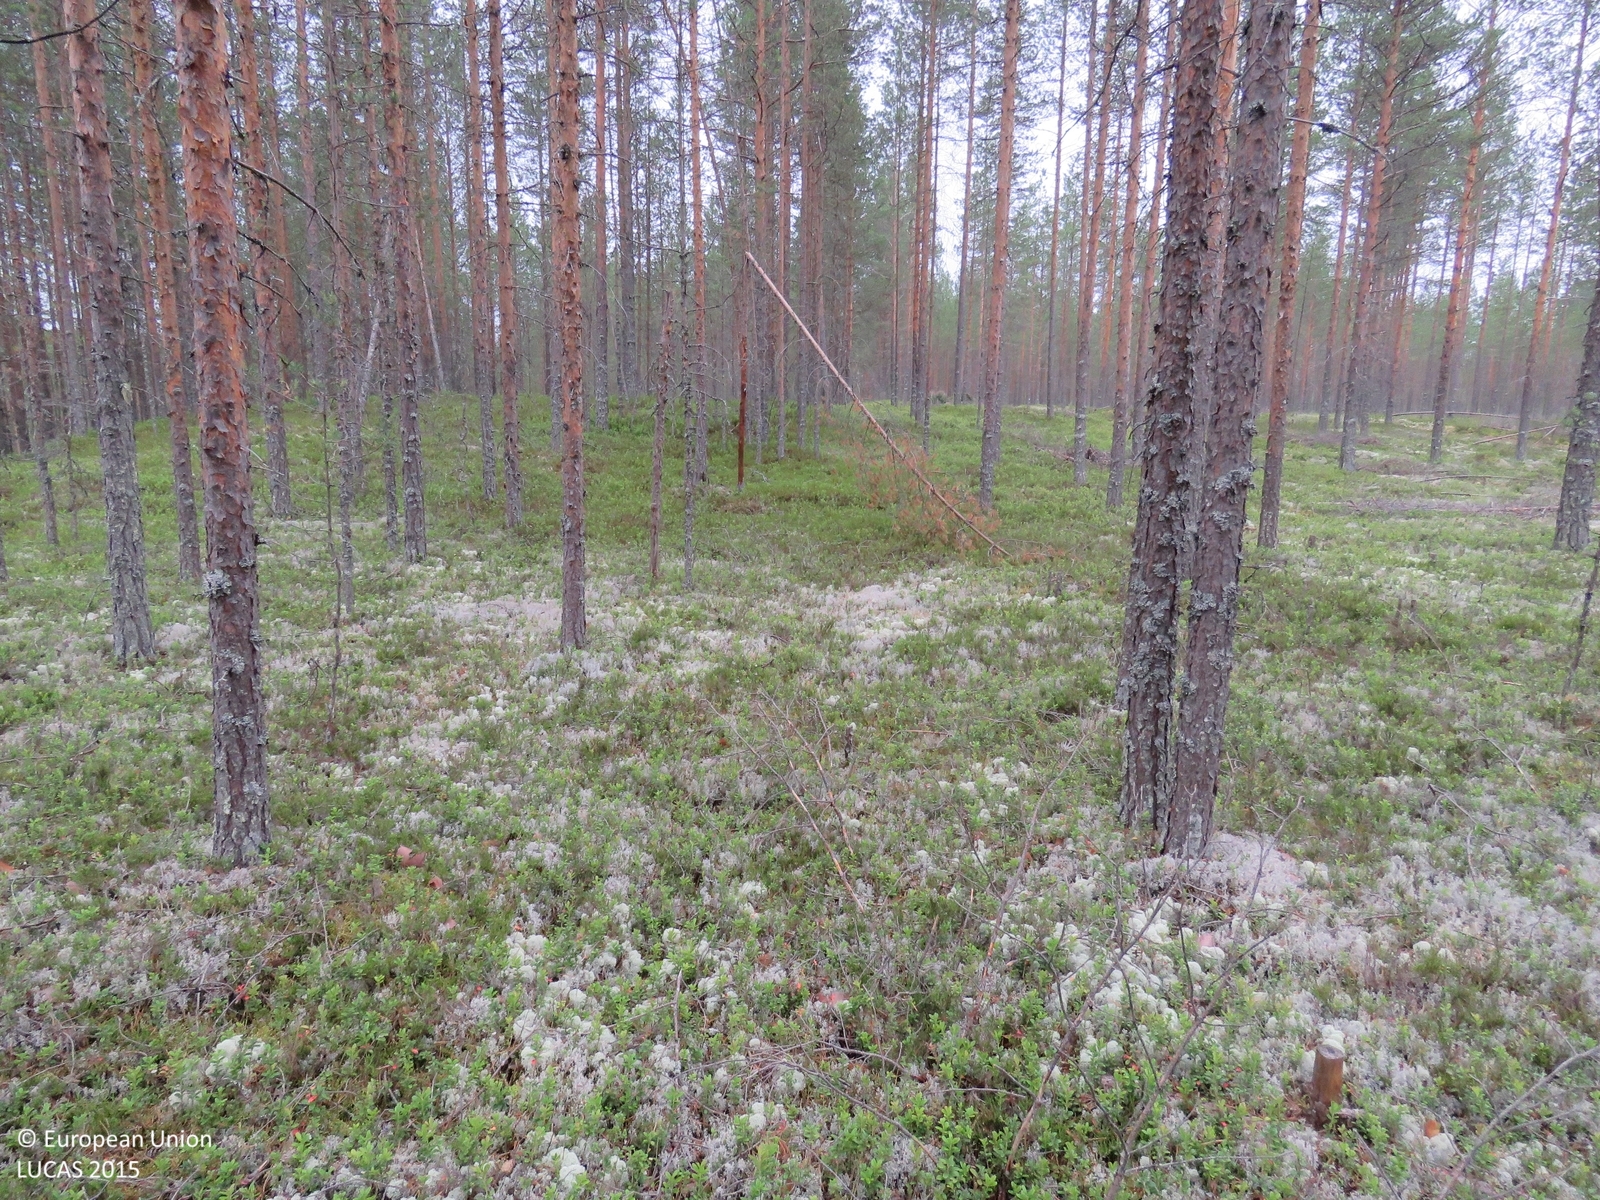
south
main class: Woodland
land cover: Pine dominated coniferous woodland
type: boreal forest
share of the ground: > 75 %
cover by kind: coniferous forest trees 80 %, shrubs 10 %, lichens and mosses 10 %
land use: Forestry
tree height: > 5 m
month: July
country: FI
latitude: 64.3241
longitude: 26.3086
